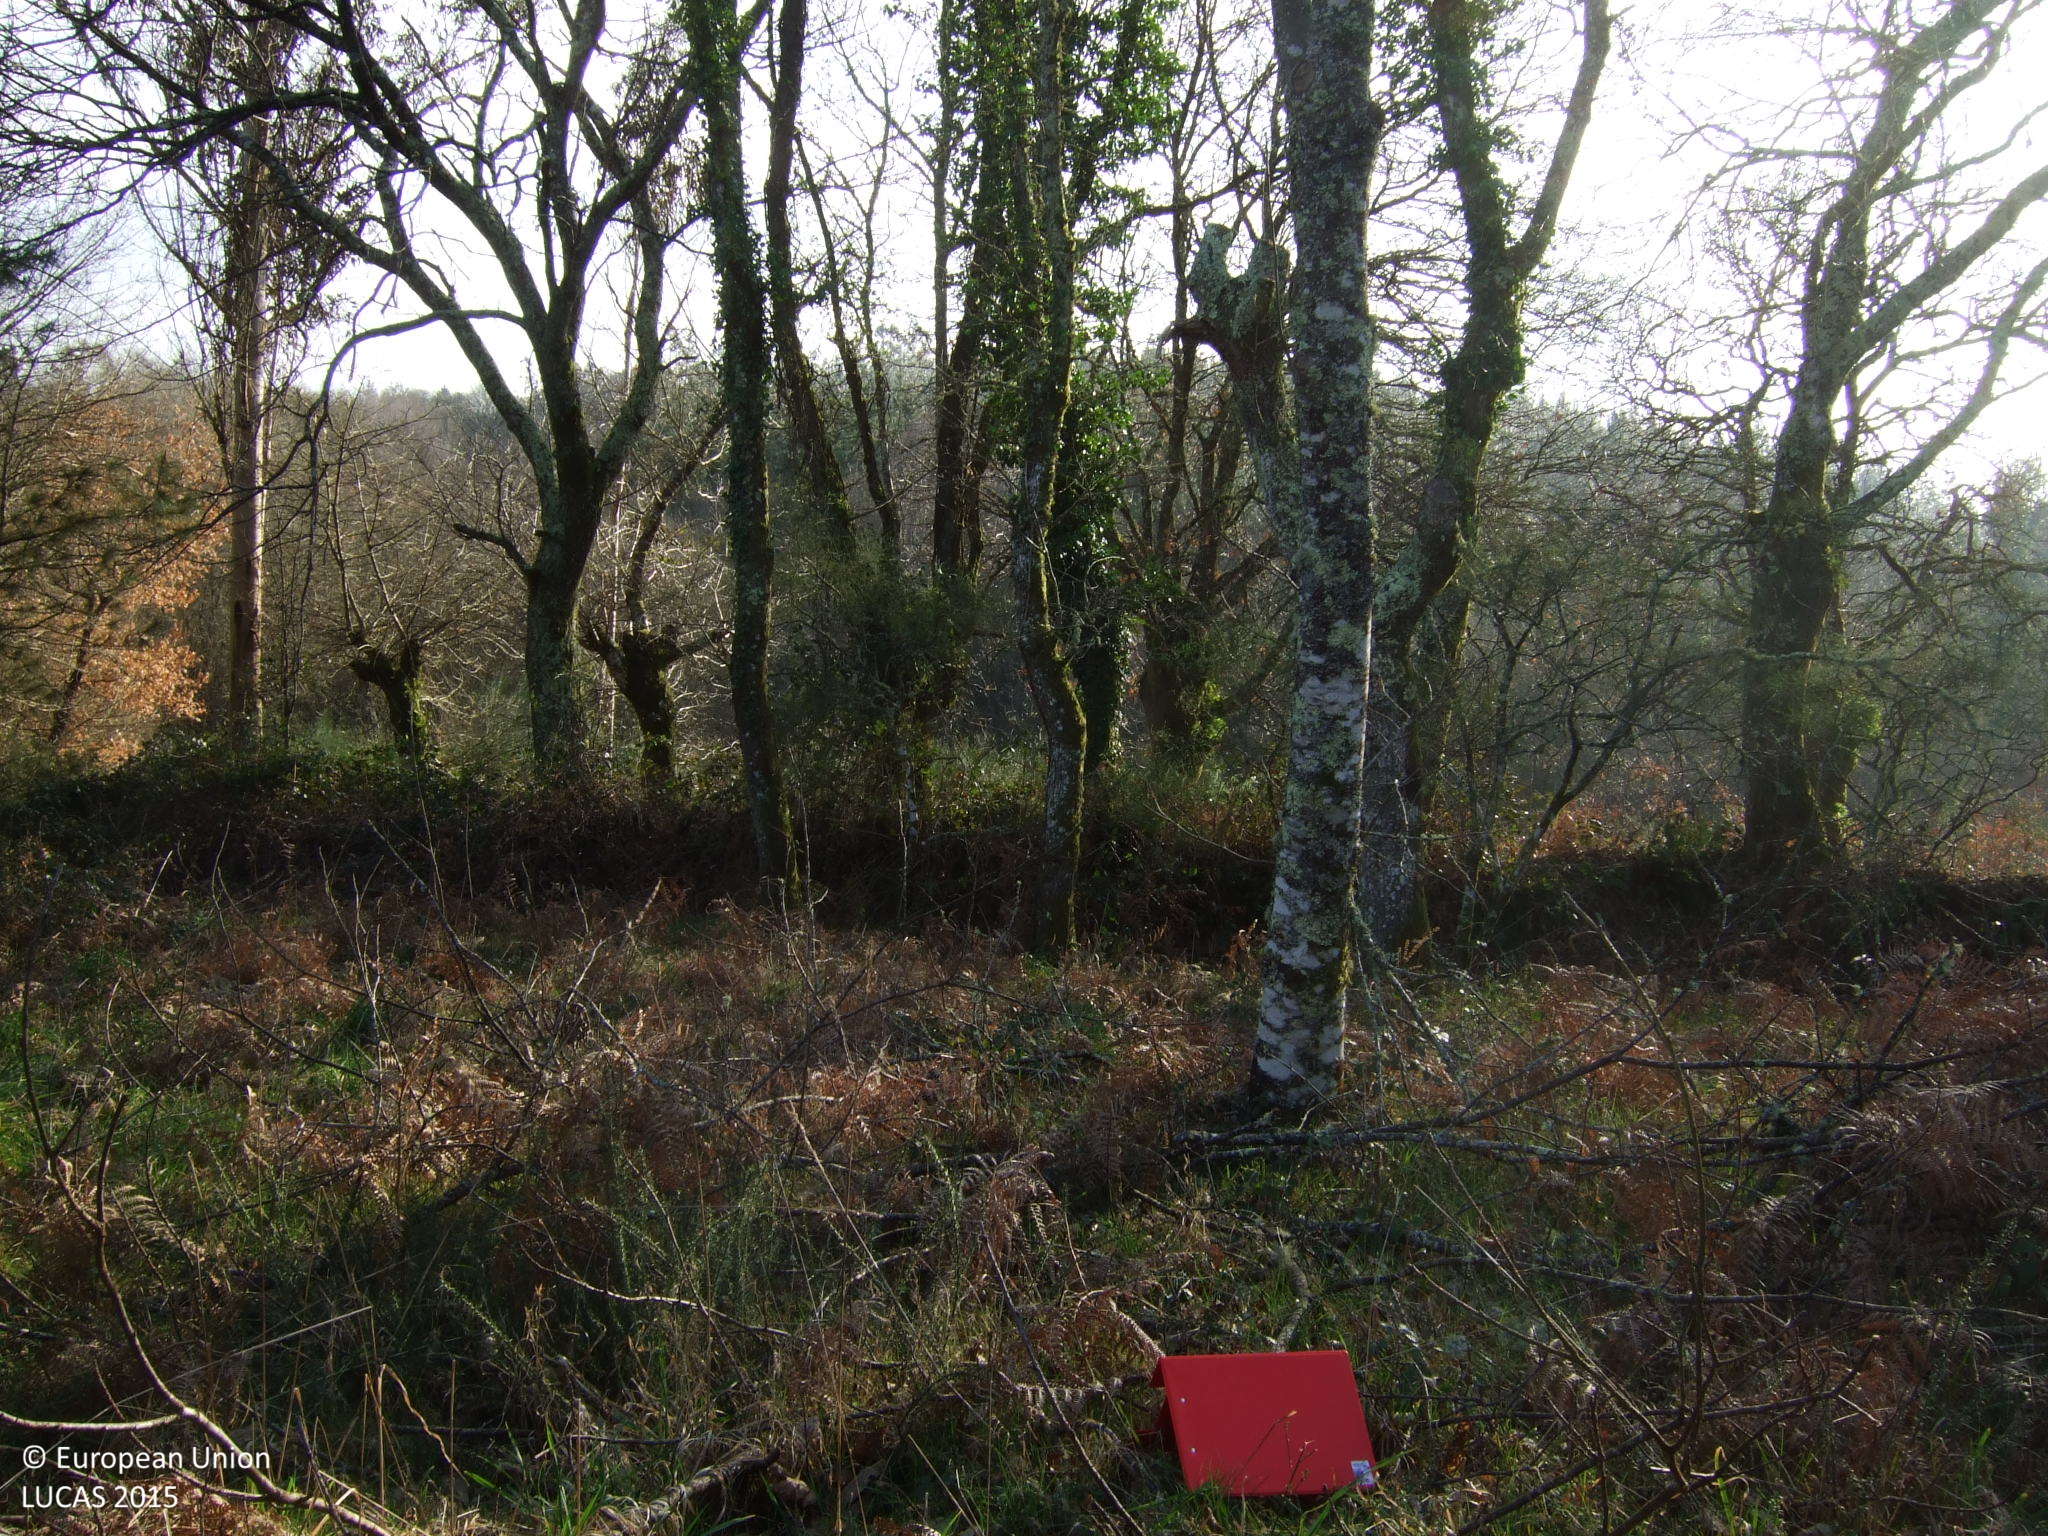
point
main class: Shrubland
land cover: Shrubland with sparse tree cover
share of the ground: > 75 %
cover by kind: shrubs 75 %, herbaceous plants 20 %, coniferous forest trees 5 %
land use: Abandoned areas
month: March
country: ES
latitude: 42.8539
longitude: -7.8907
